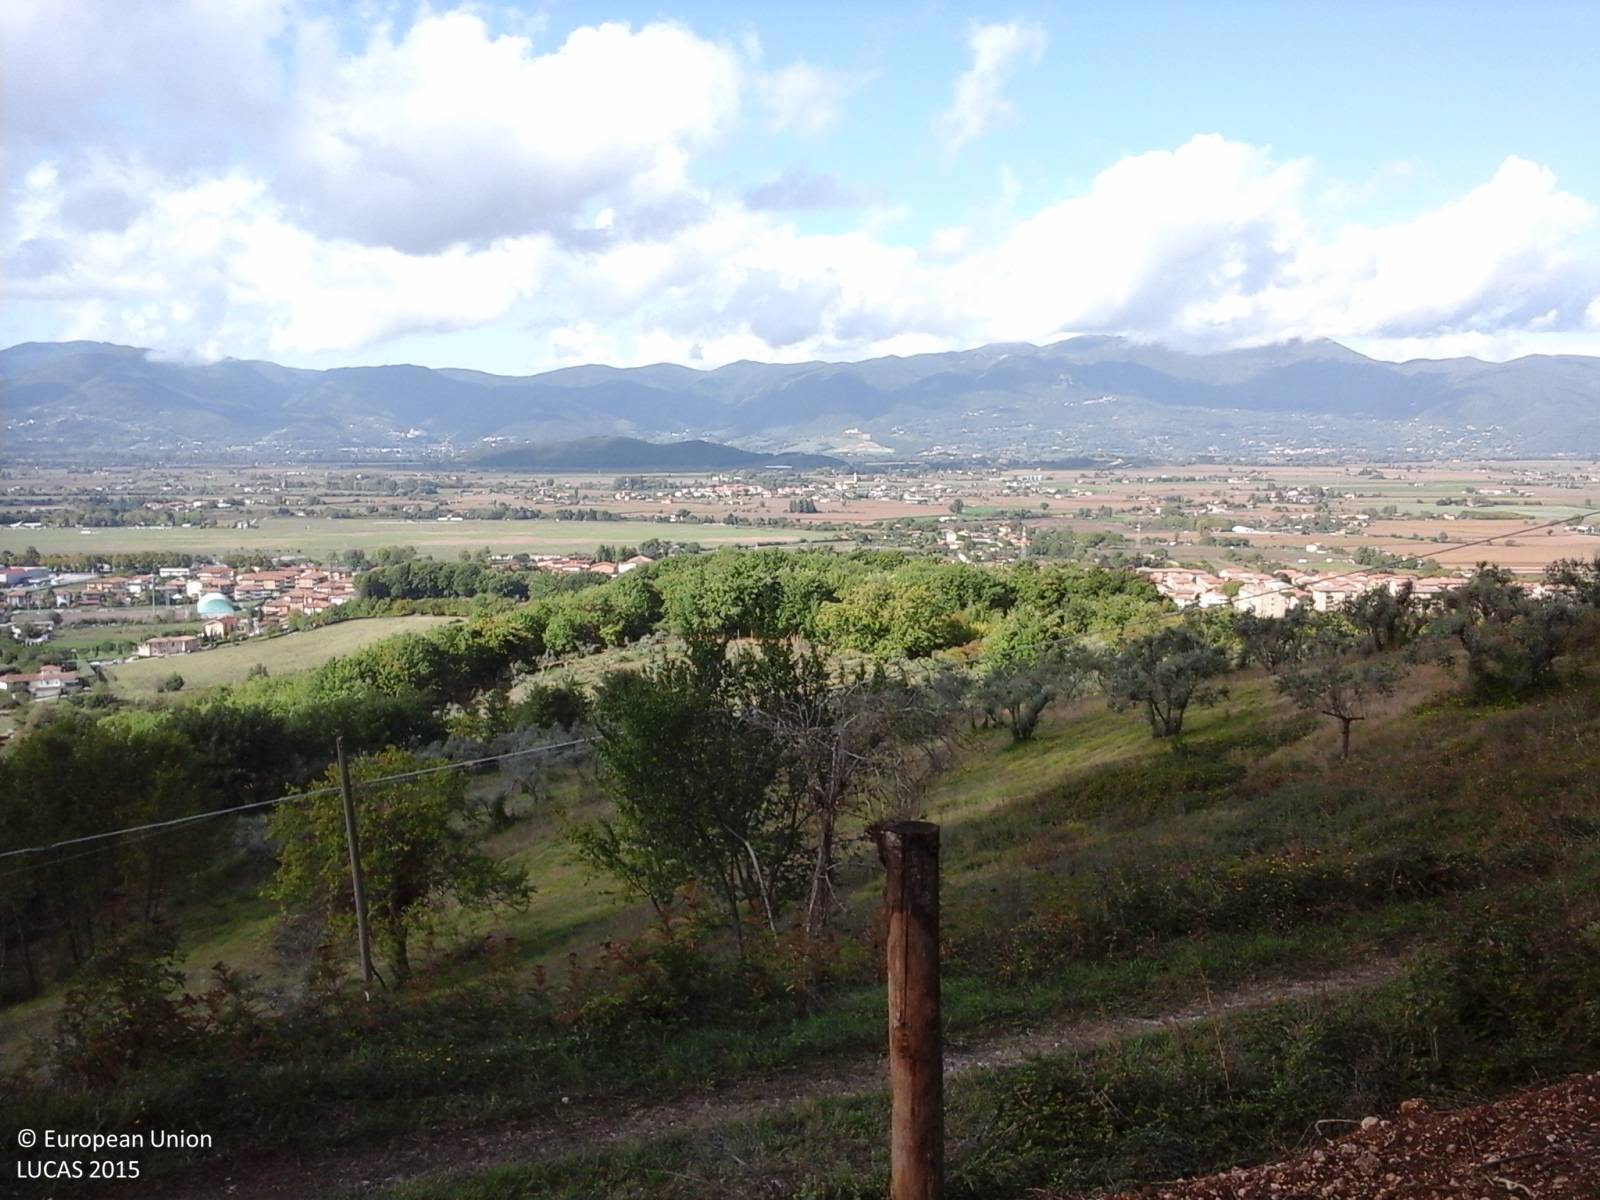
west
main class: Woodland
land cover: Broadleaved woodland
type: thermophilous deciduous forest
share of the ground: > 75 %
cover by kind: broadleaved forest trees 95 %, shrubs 5 %
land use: Forestry
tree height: > 5 m
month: October
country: IT
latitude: 42.4326
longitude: 12.8714
